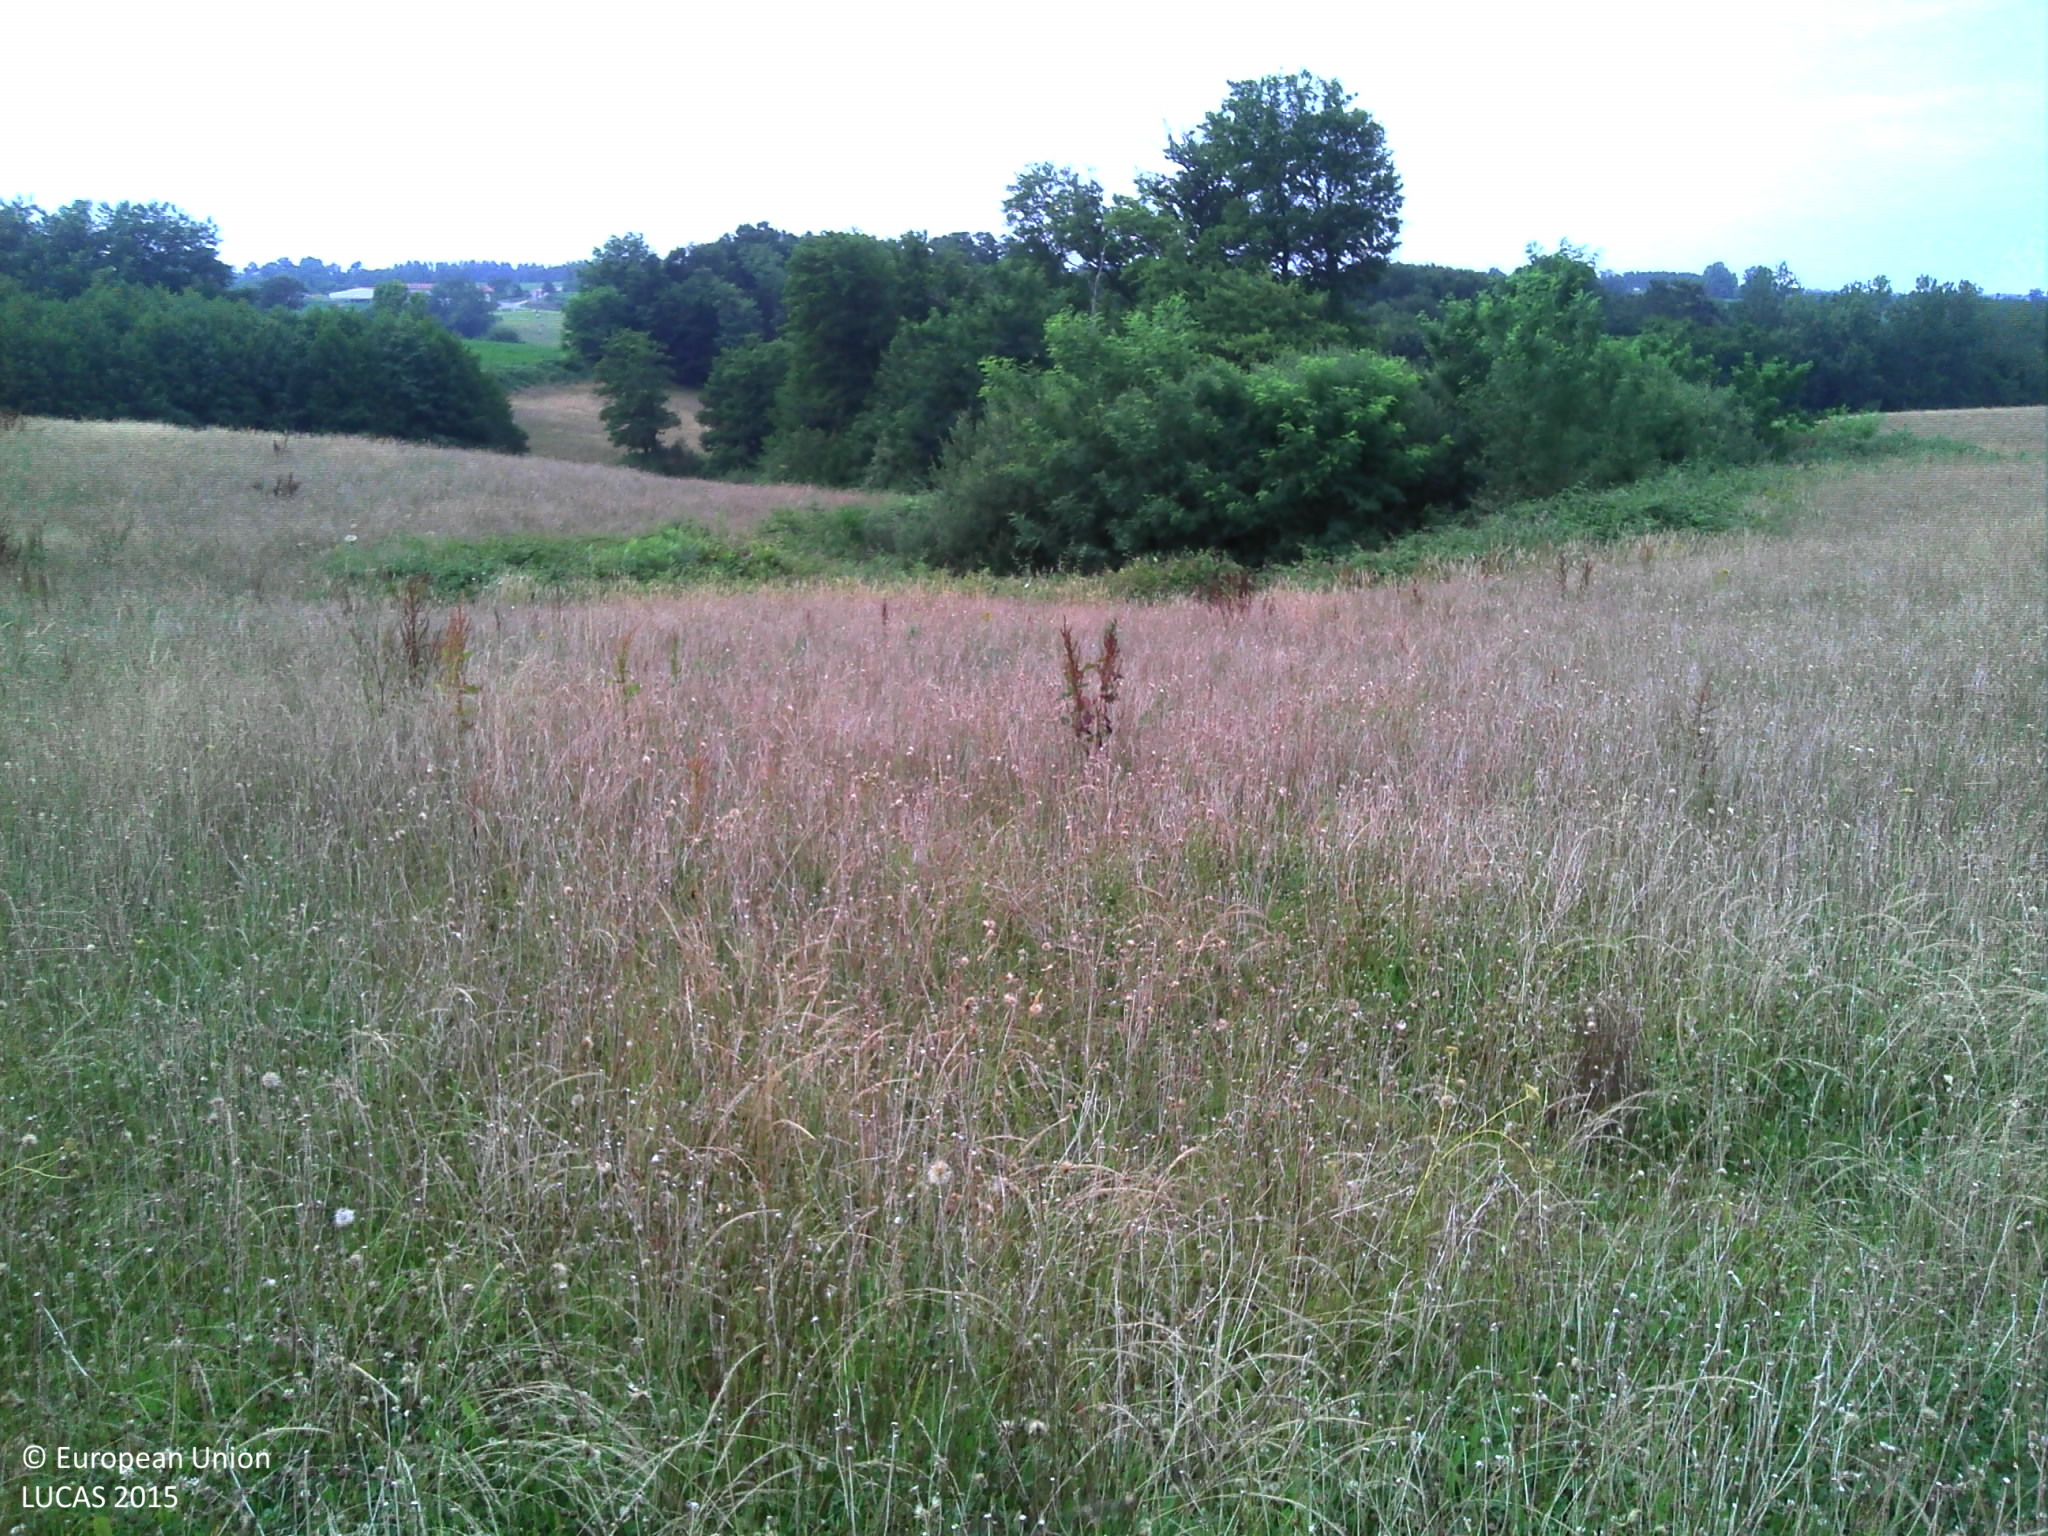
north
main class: Grassland
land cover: Grassland without tree/shrub cover
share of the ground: > 75 %
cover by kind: herbaceous plants 100 %
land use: Agriculture (excluding fallow land and kitchen gardens)
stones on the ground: < 10 %
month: July
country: FR
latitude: 43.6796
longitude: -0.7673
